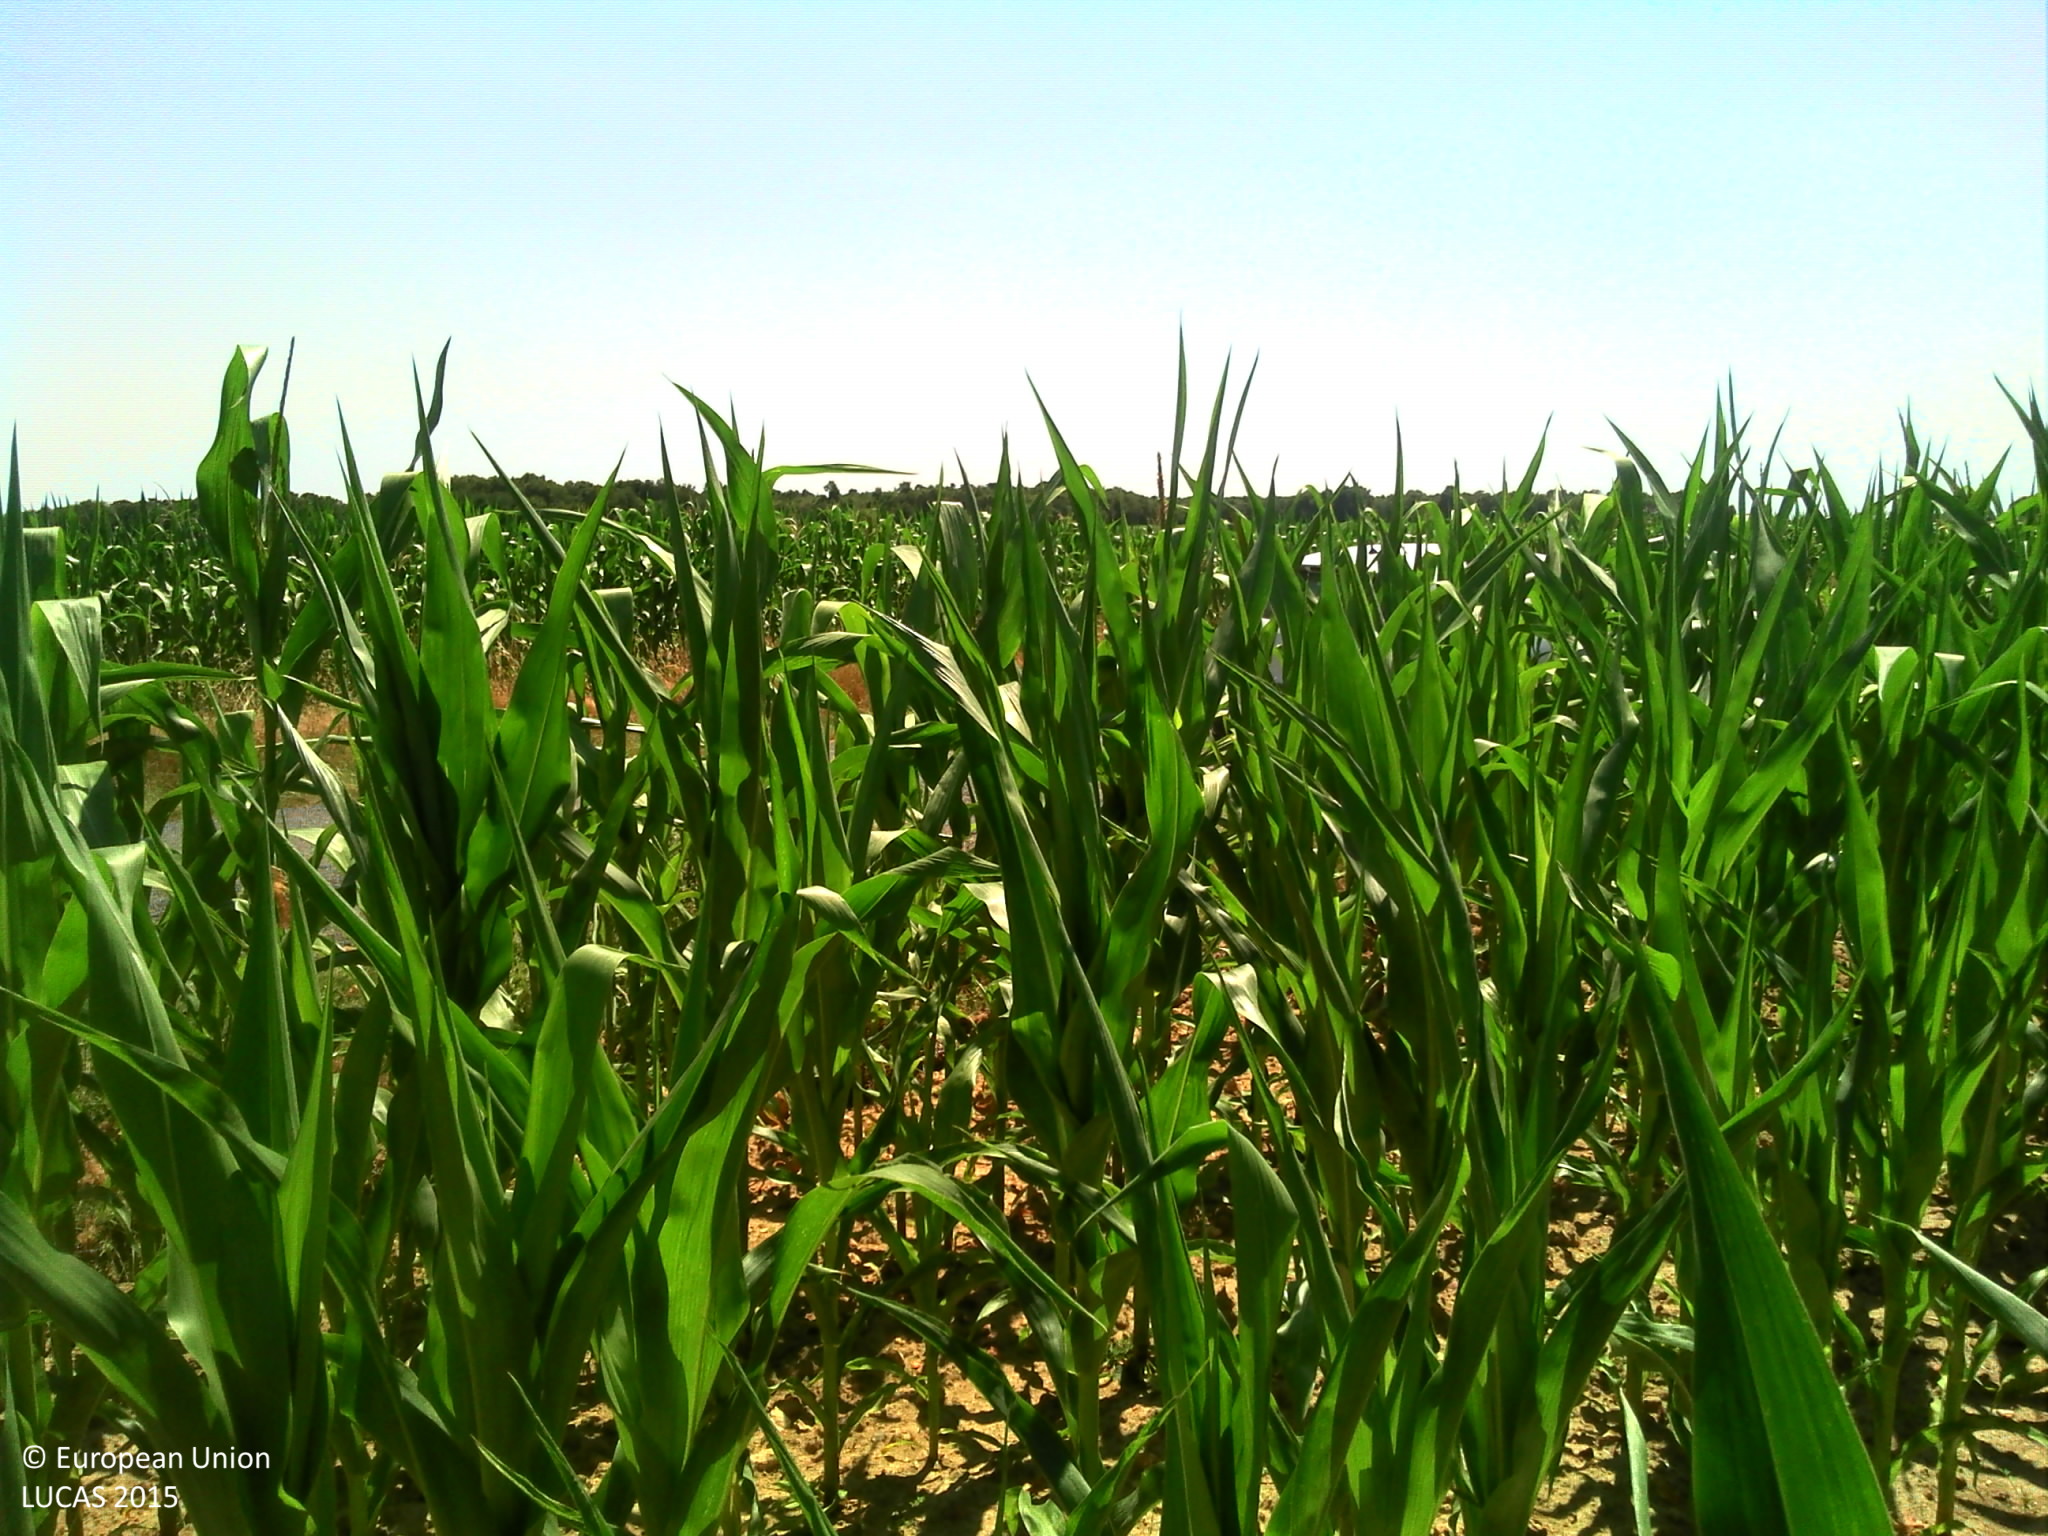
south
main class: Cropland
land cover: Maize
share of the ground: 25 - 50 %
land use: Agriculture (excluding fallow land and kitchen gardens)
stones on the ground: 10 - 25 %
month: July
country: FR
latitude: 47.2182
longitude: 0.7515
